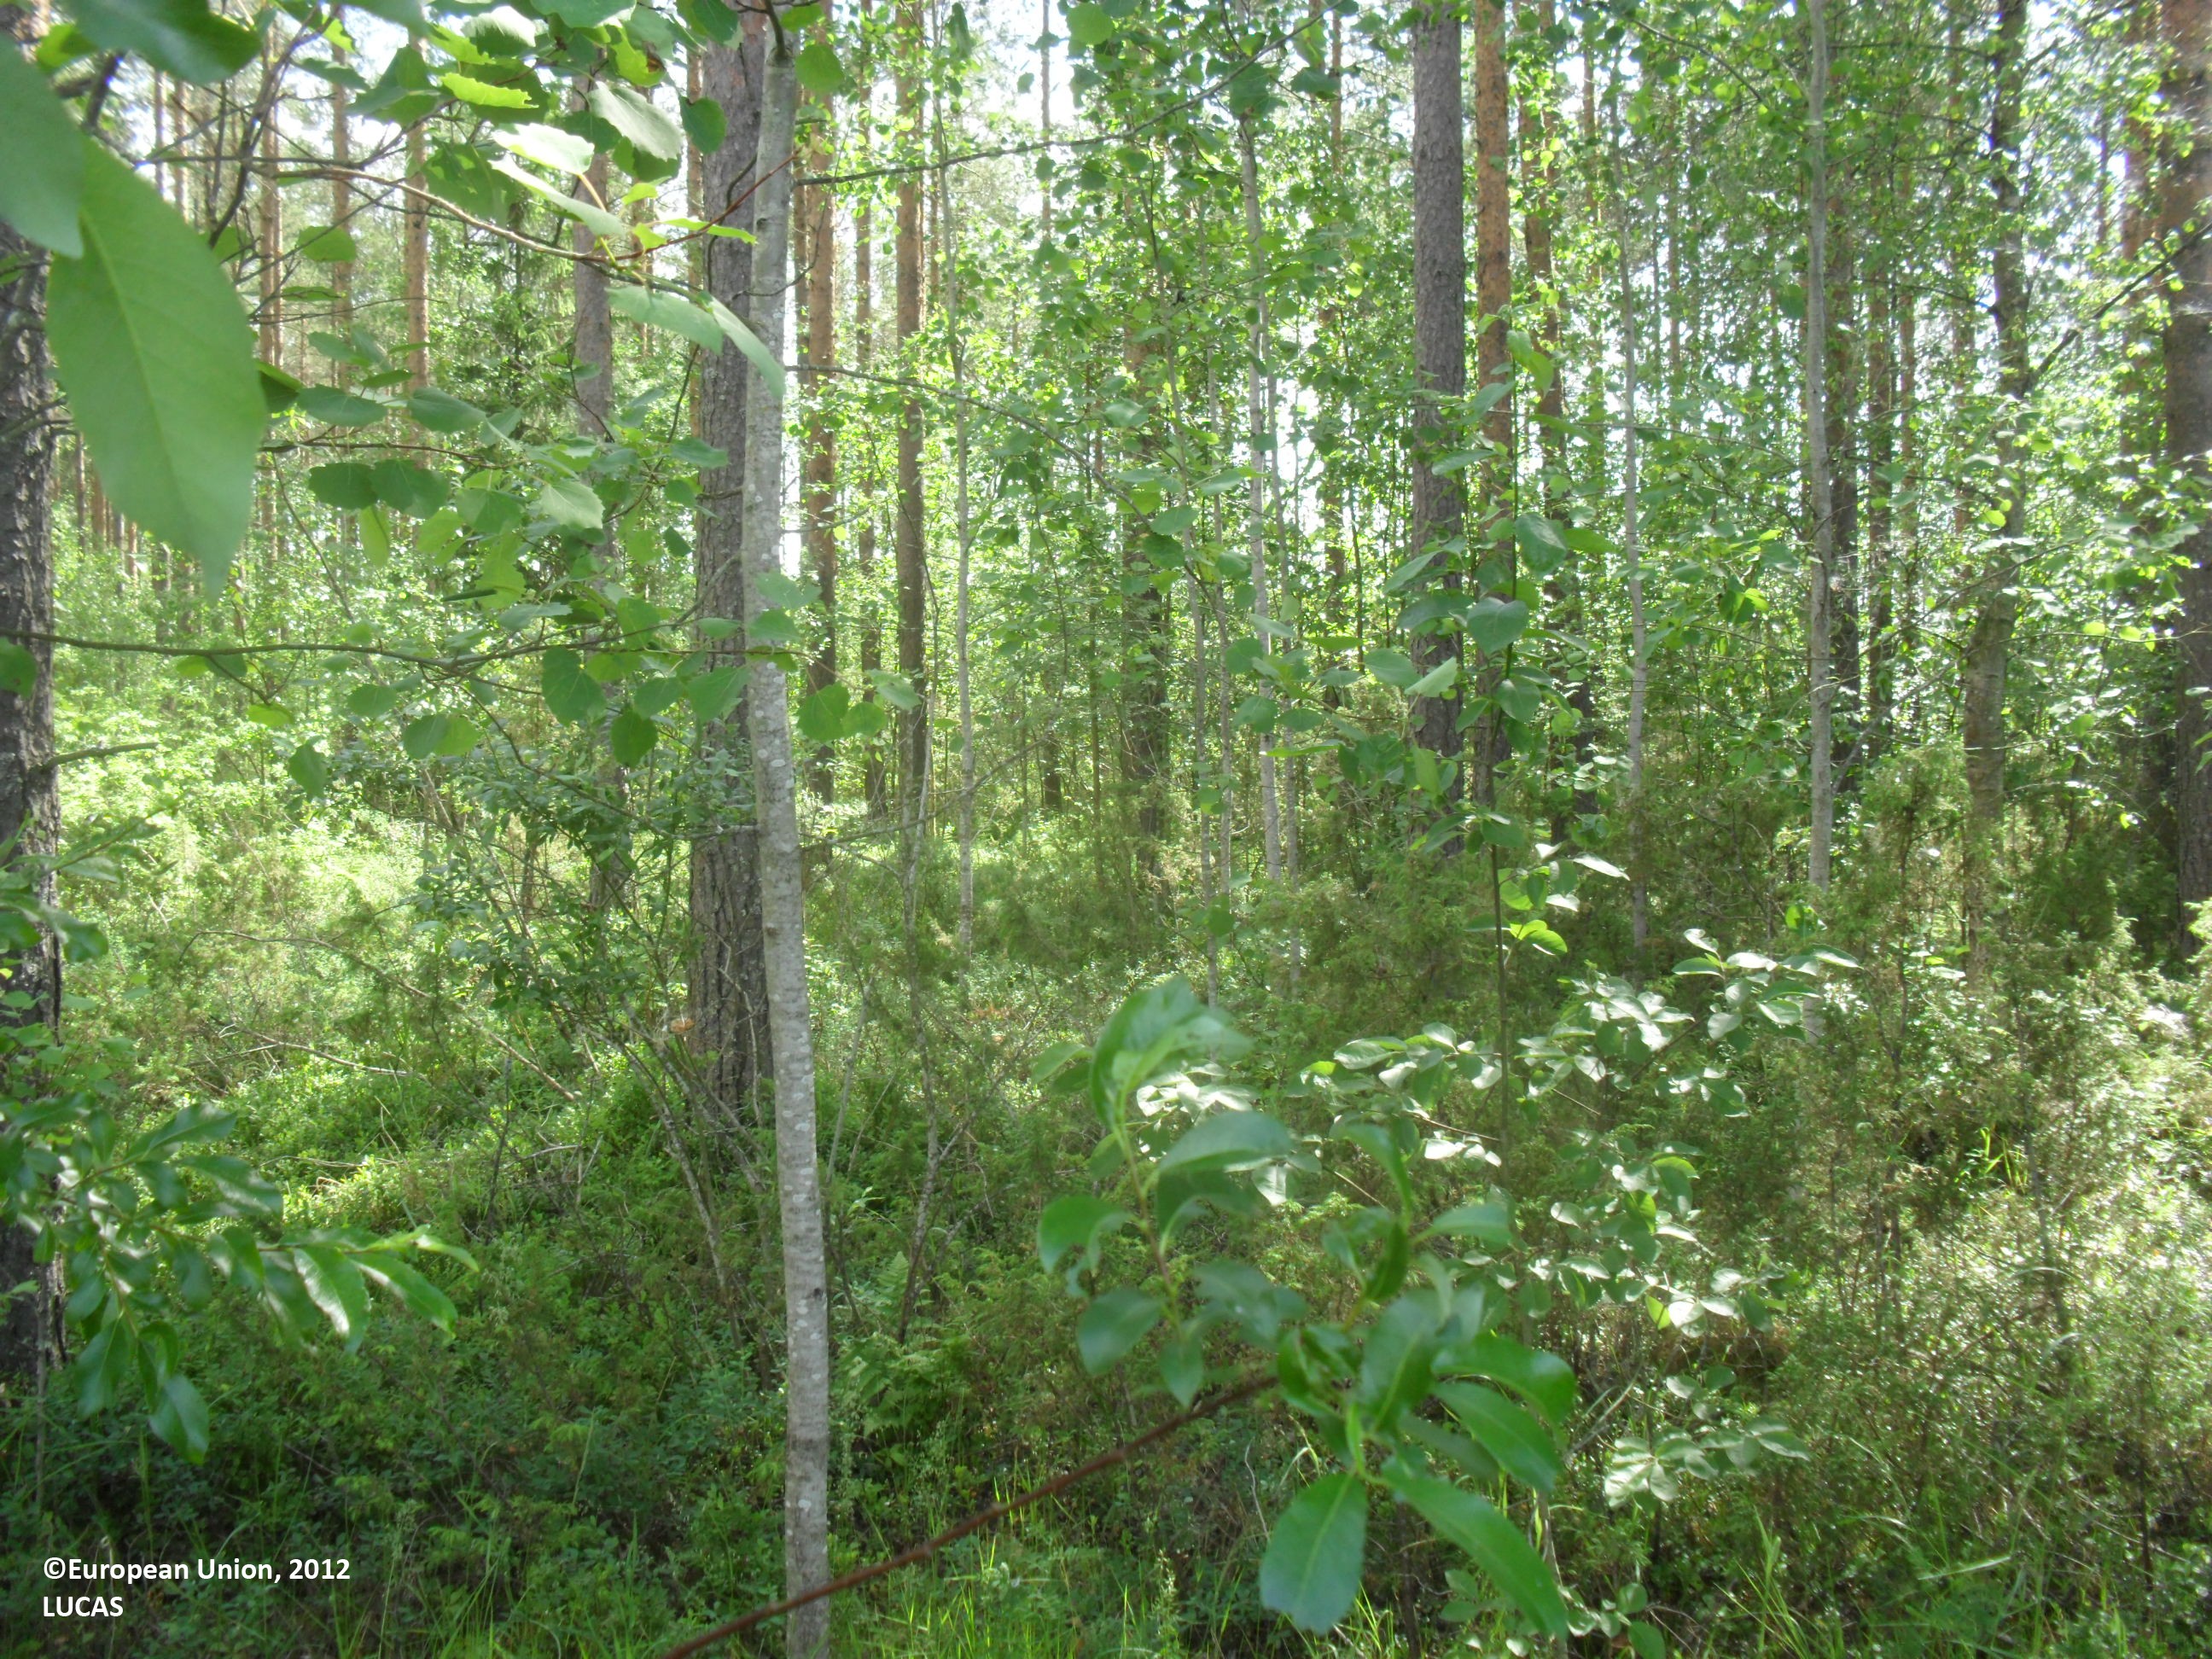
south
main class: Woodland
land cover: Pine dominated mixed woodland
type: boreal forest
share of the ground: 50 - 75 %
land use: Forestry
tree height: > 5 m
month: July
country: FI
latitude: 63.4563
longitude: 23.8475
